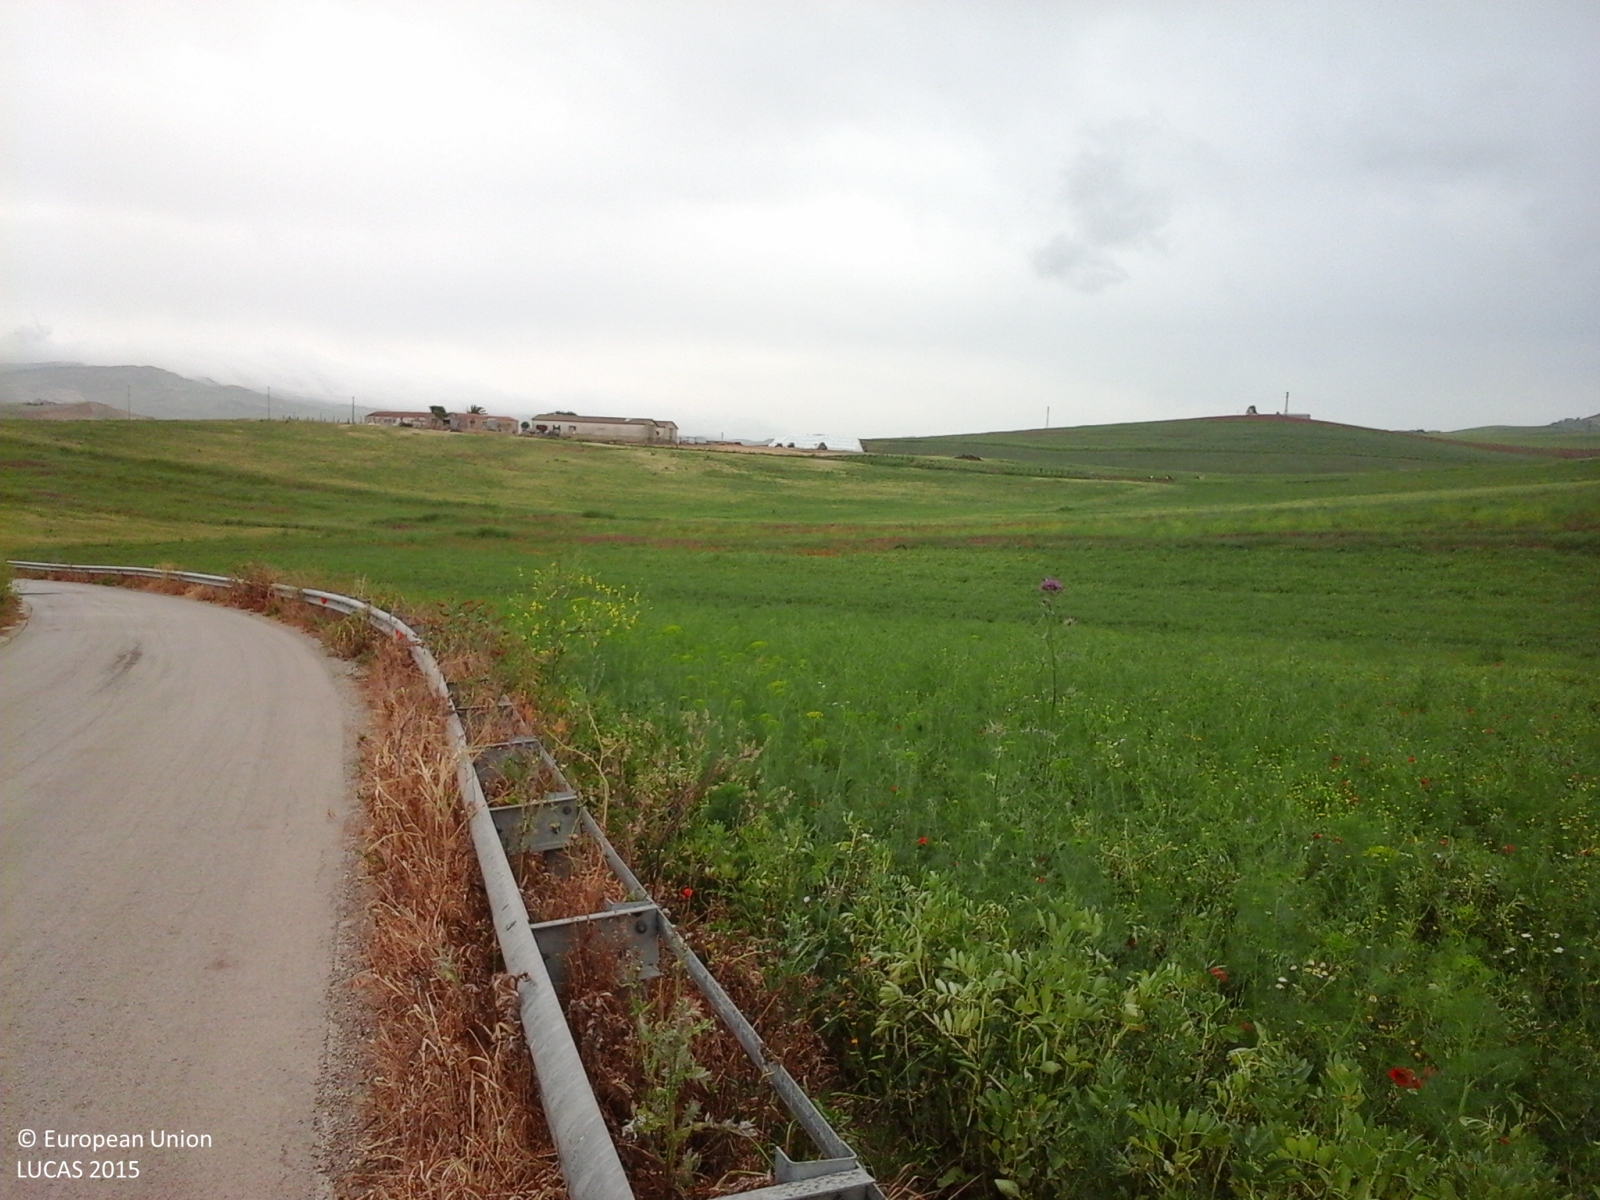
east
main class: Cropland
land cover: Temporary grasslands
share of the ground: > 75 %
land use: Agriculture (excluding fallow land and kitchen gardens)
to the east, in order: Temporary grasslands; Arable land (only in case pi)
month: May
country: IT
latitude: 37.7126
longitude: 13.6824
